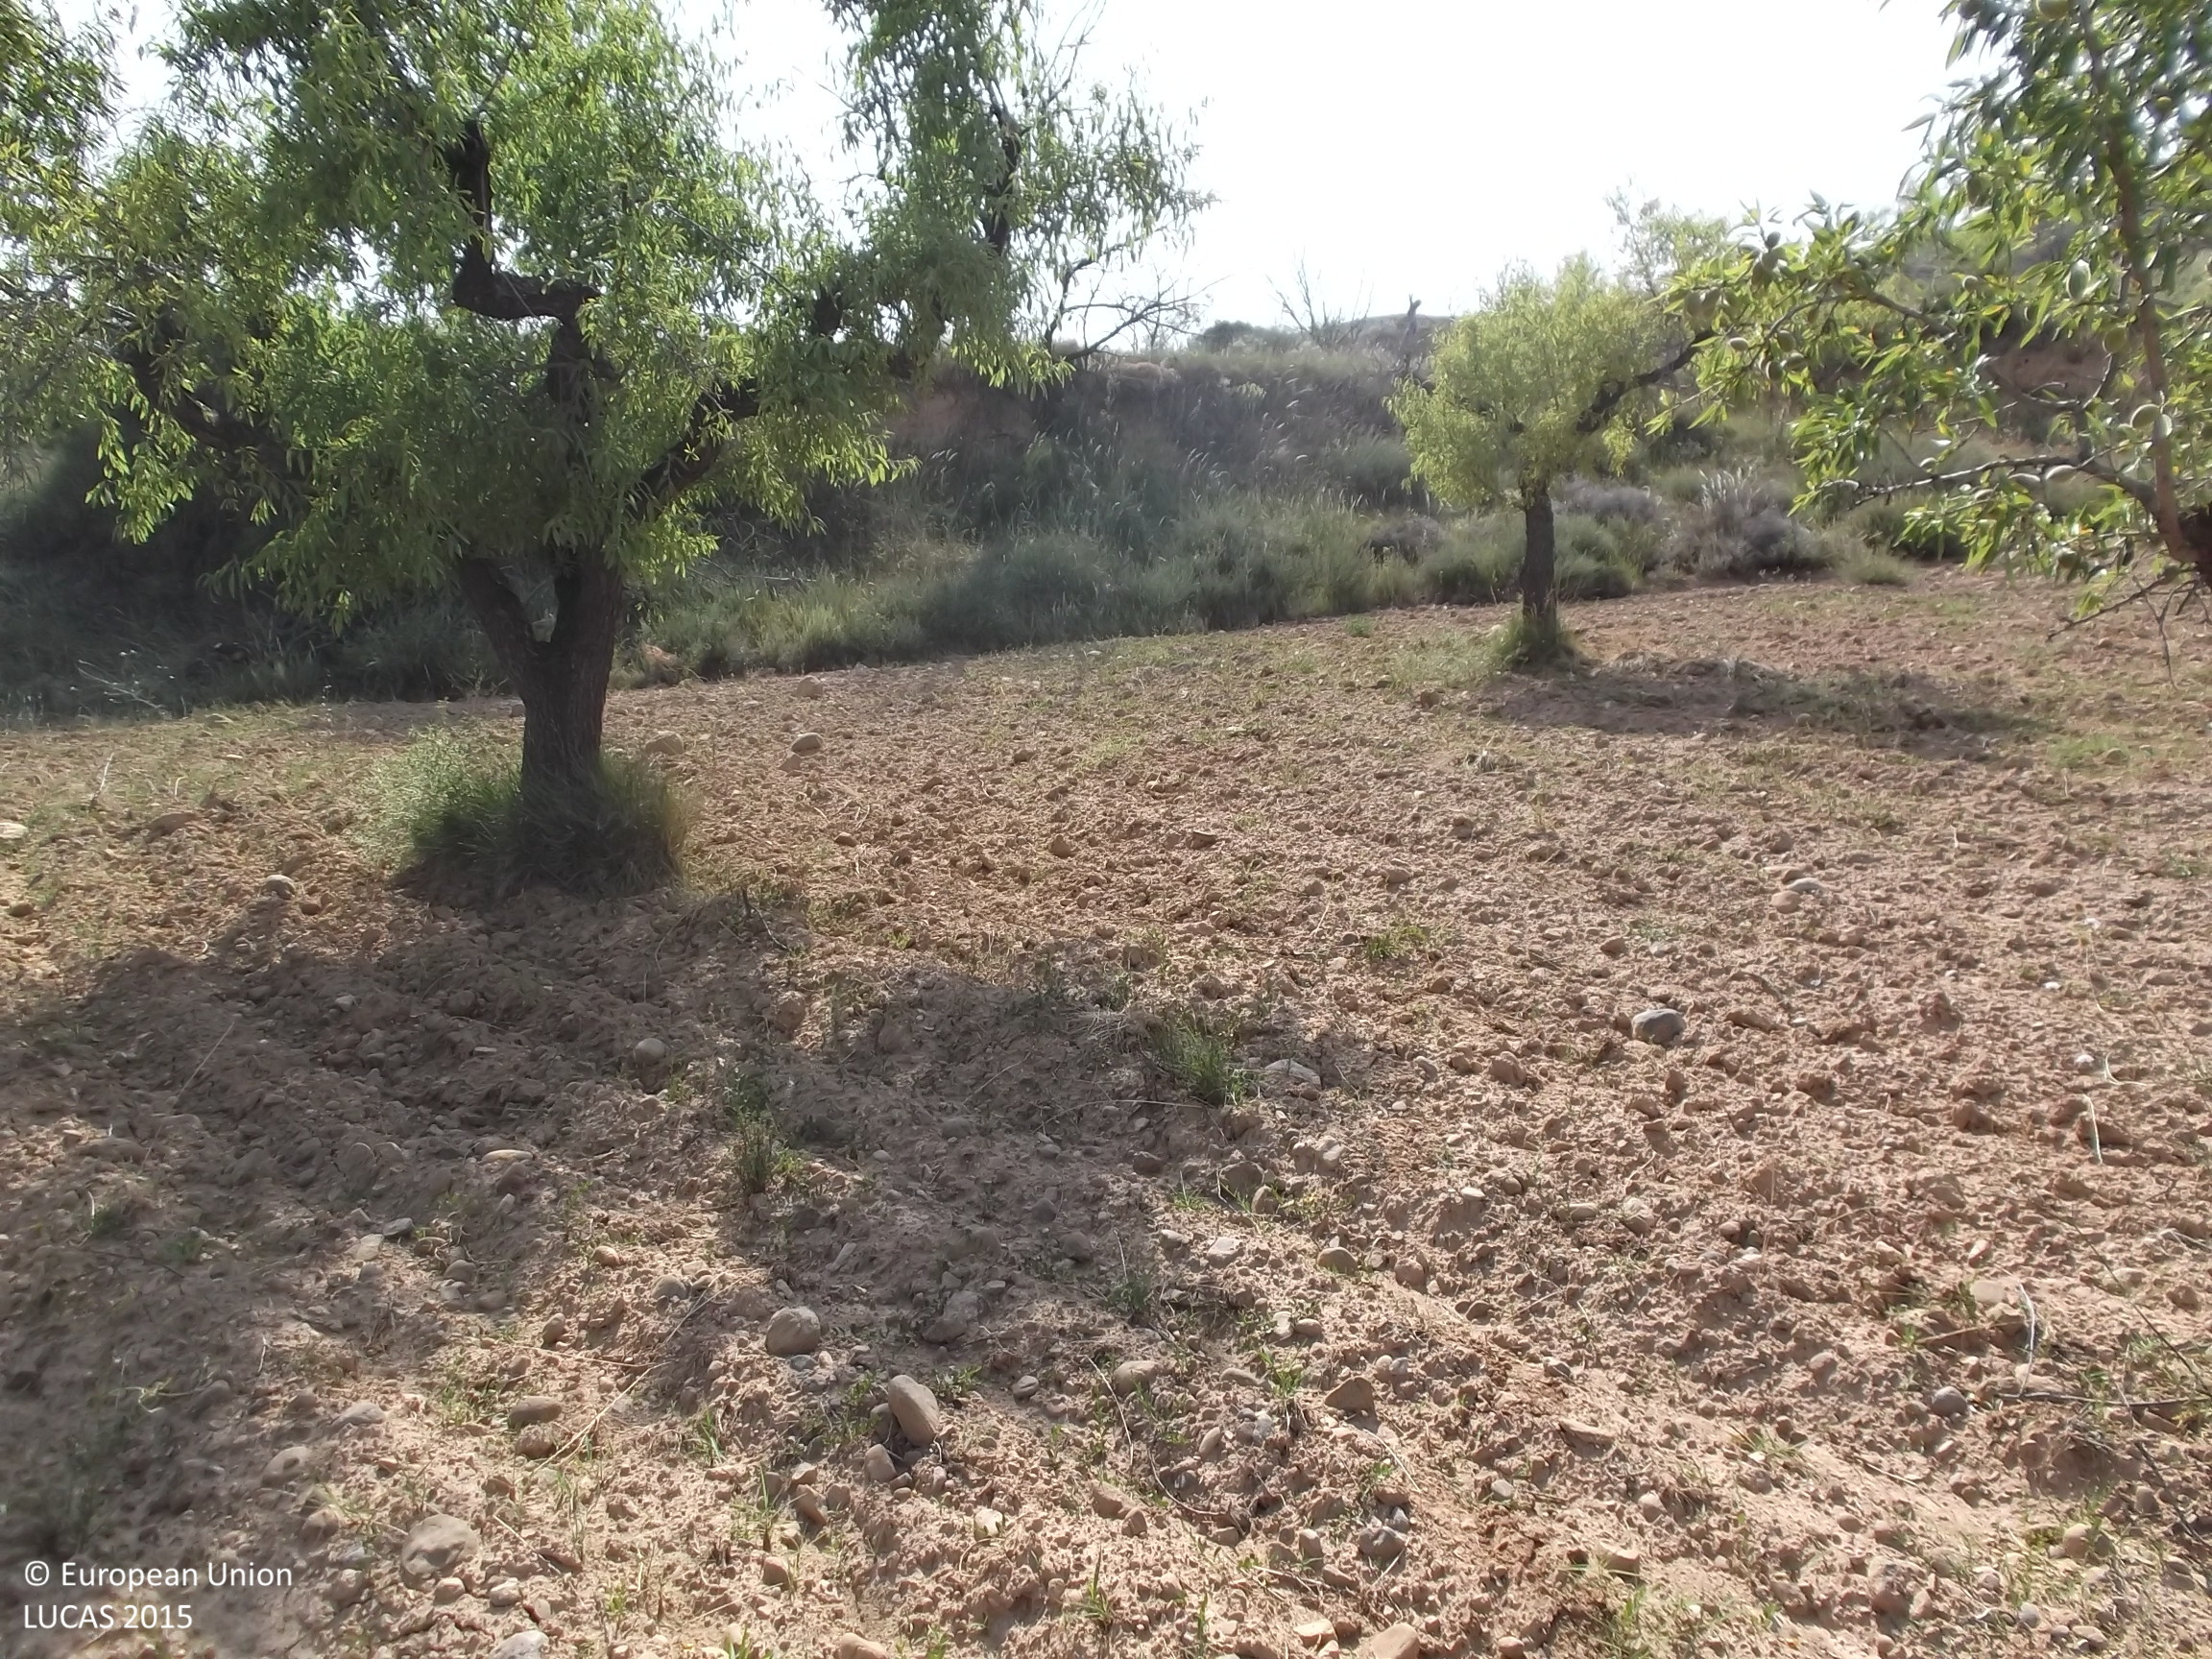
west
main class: Cropland
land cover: Nuts trees
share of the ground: 10 - 25 %
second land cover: Other bare soil
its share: > 75 %
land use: Agriculture (excluding fallow land and kitchen gardens)
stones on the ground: 10 - 25 %
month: July
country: ES
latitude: 42.2335
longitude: -2.1196
